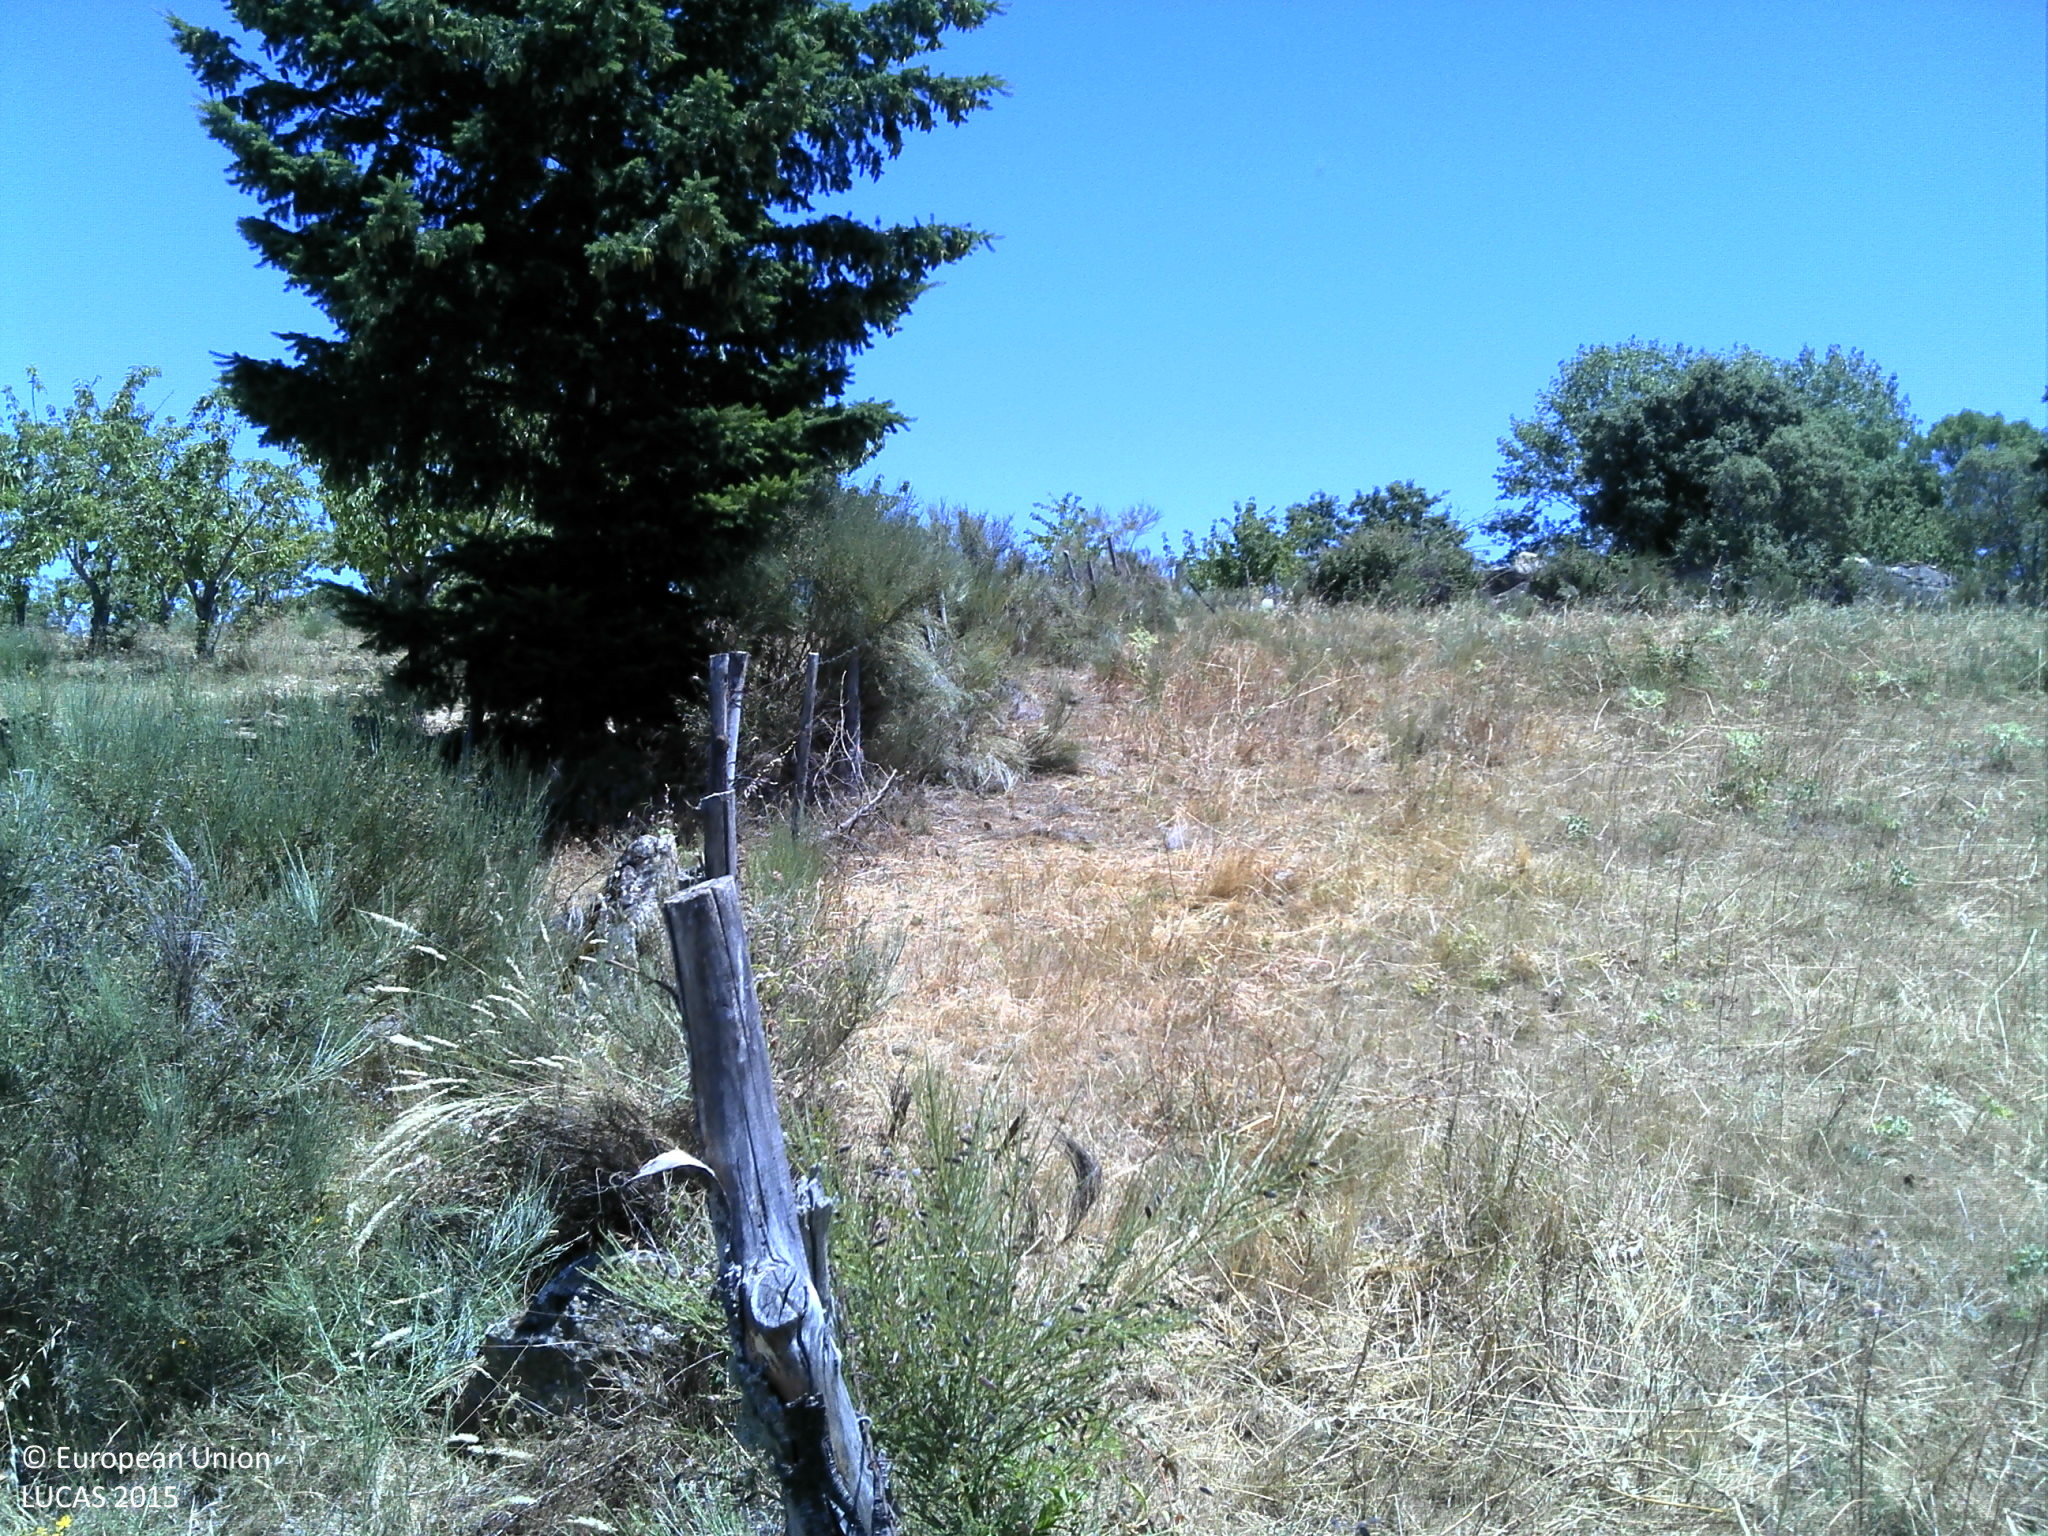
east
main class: Grassland
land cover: Grassland without tree/shrub cover
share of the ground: > 75 %
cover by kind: herbaceous plants 100 %
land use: Agriculture (excluding fallow land and kitchen gardens)
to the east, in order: Grassland without tree/shrub cover; Abandoned hedges; Shrubland with sparse tree cover; Grassland without tree/shrub cover; Fences; Shruby margins; Cherry fruit; Grass margins; Tracks; Grassland with sparse tree/shrub cover; Artificial constructions; Grassland without tree/shrub cover
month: June
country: PT
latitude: 41.4787
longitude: -7.0120
